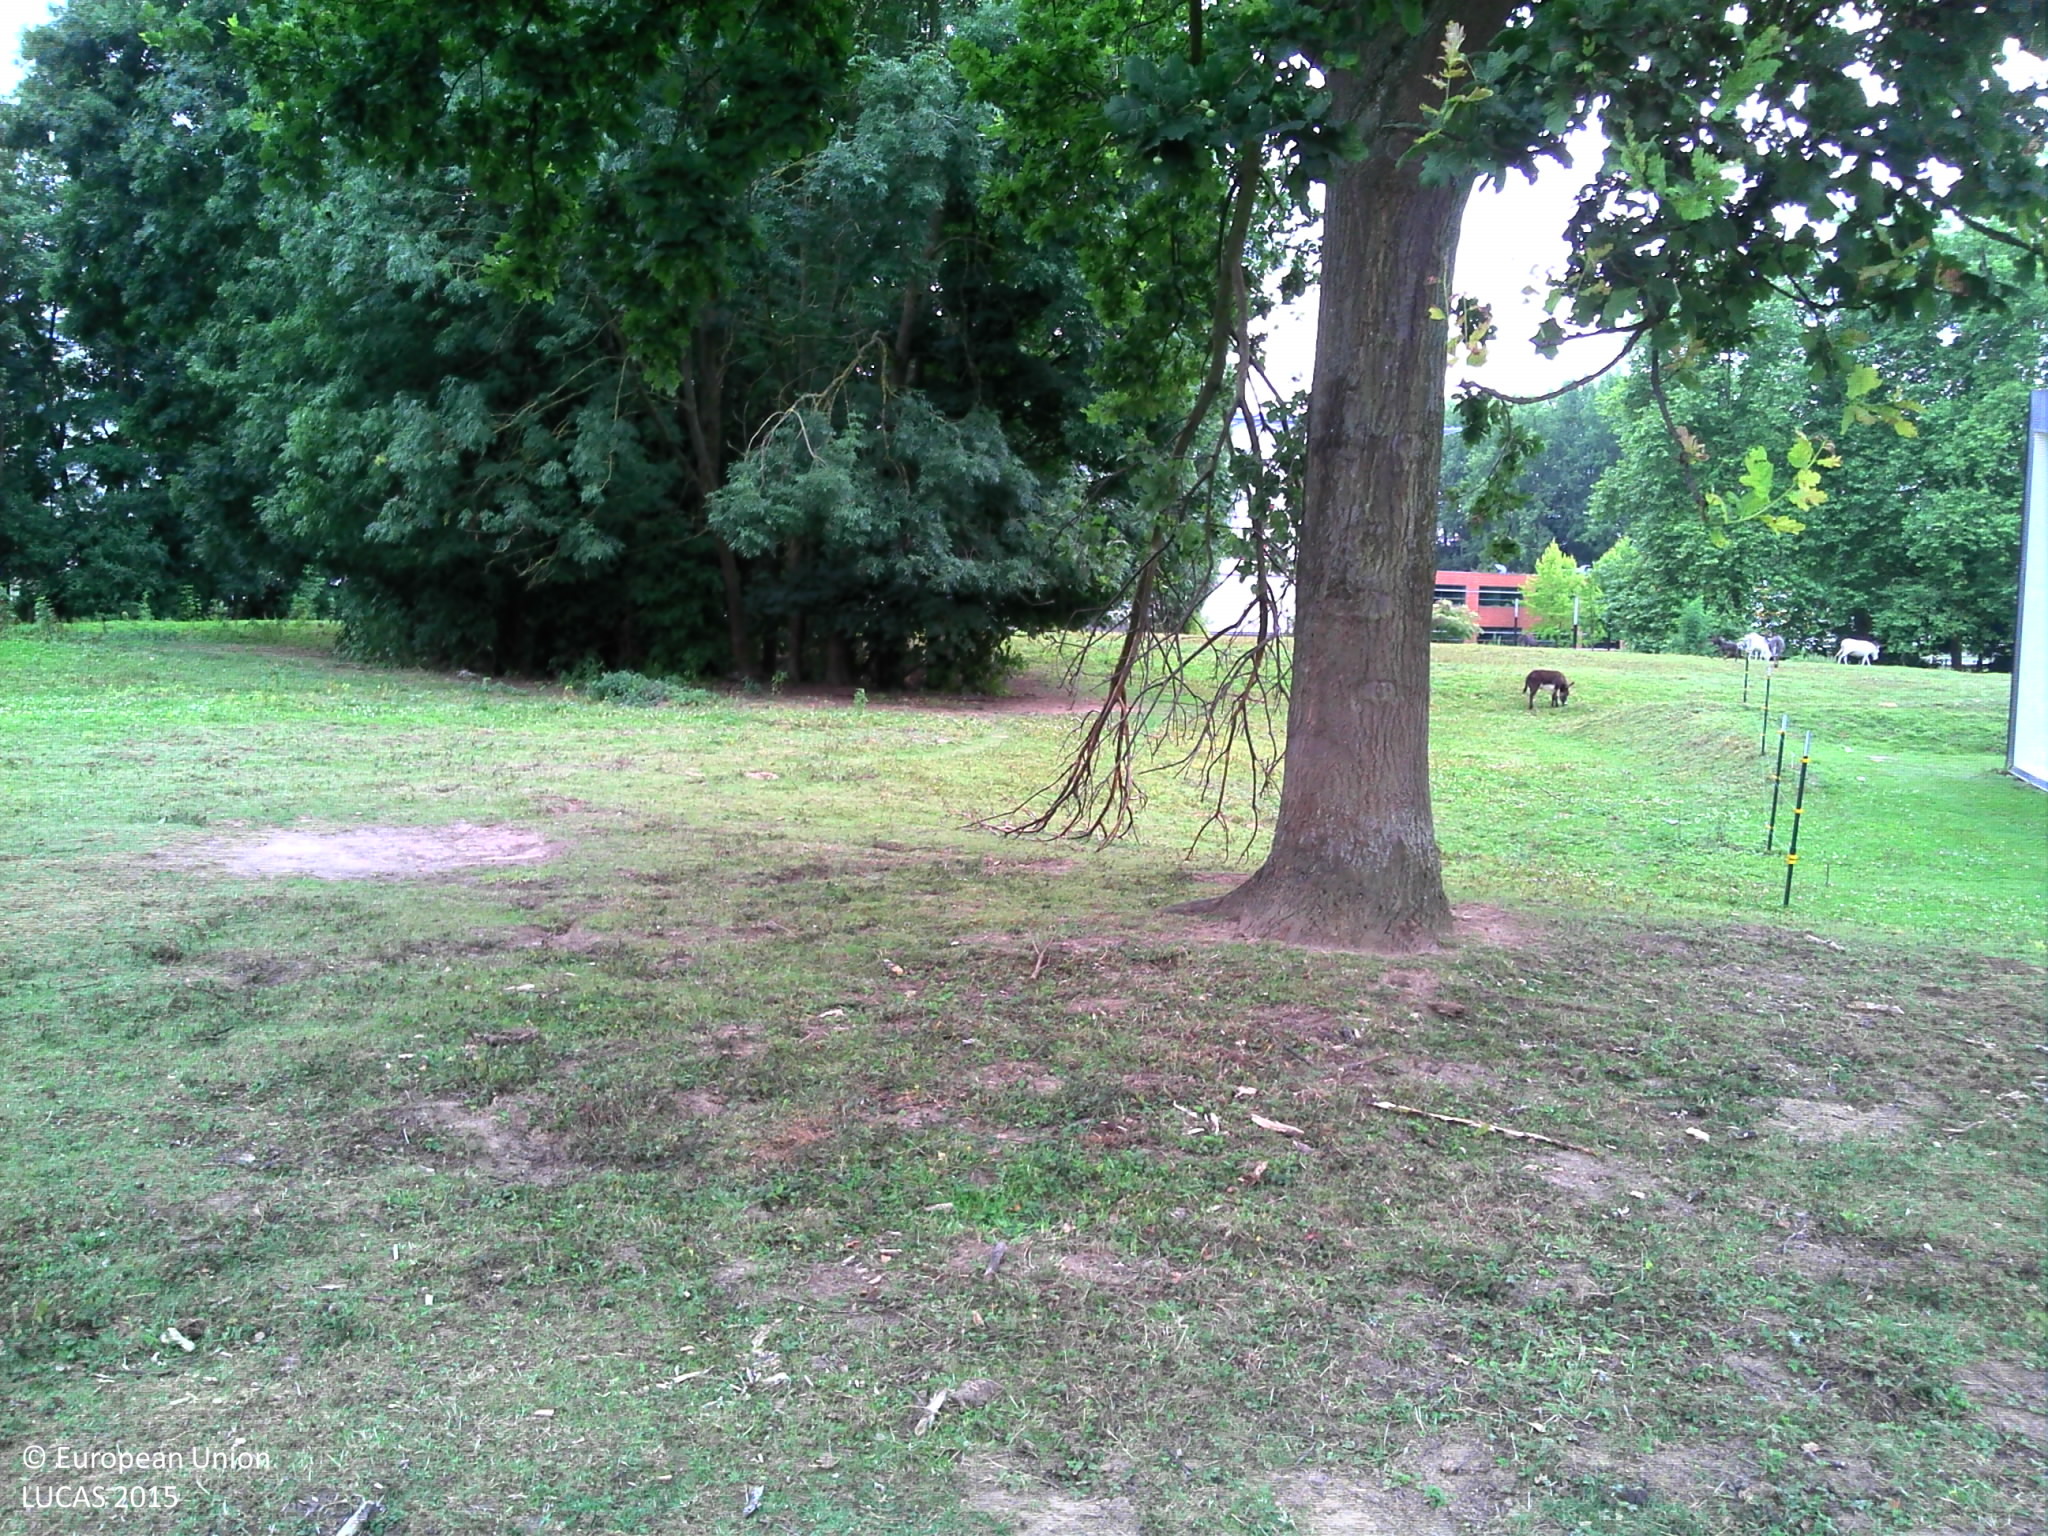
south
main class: Grassland
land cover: Grassland with sparse tree/shrub cover
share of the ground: > 75 %
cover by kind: herbaceous plants 90 %, broadleaved forest trees 5 %, lichens and mosses 5 %
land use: Agriculture (excluding fallow land and kitchen gardens)
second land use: Community services
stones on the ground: < 10 %
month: August
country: FR
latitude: 50.6090
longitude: 3.1371
